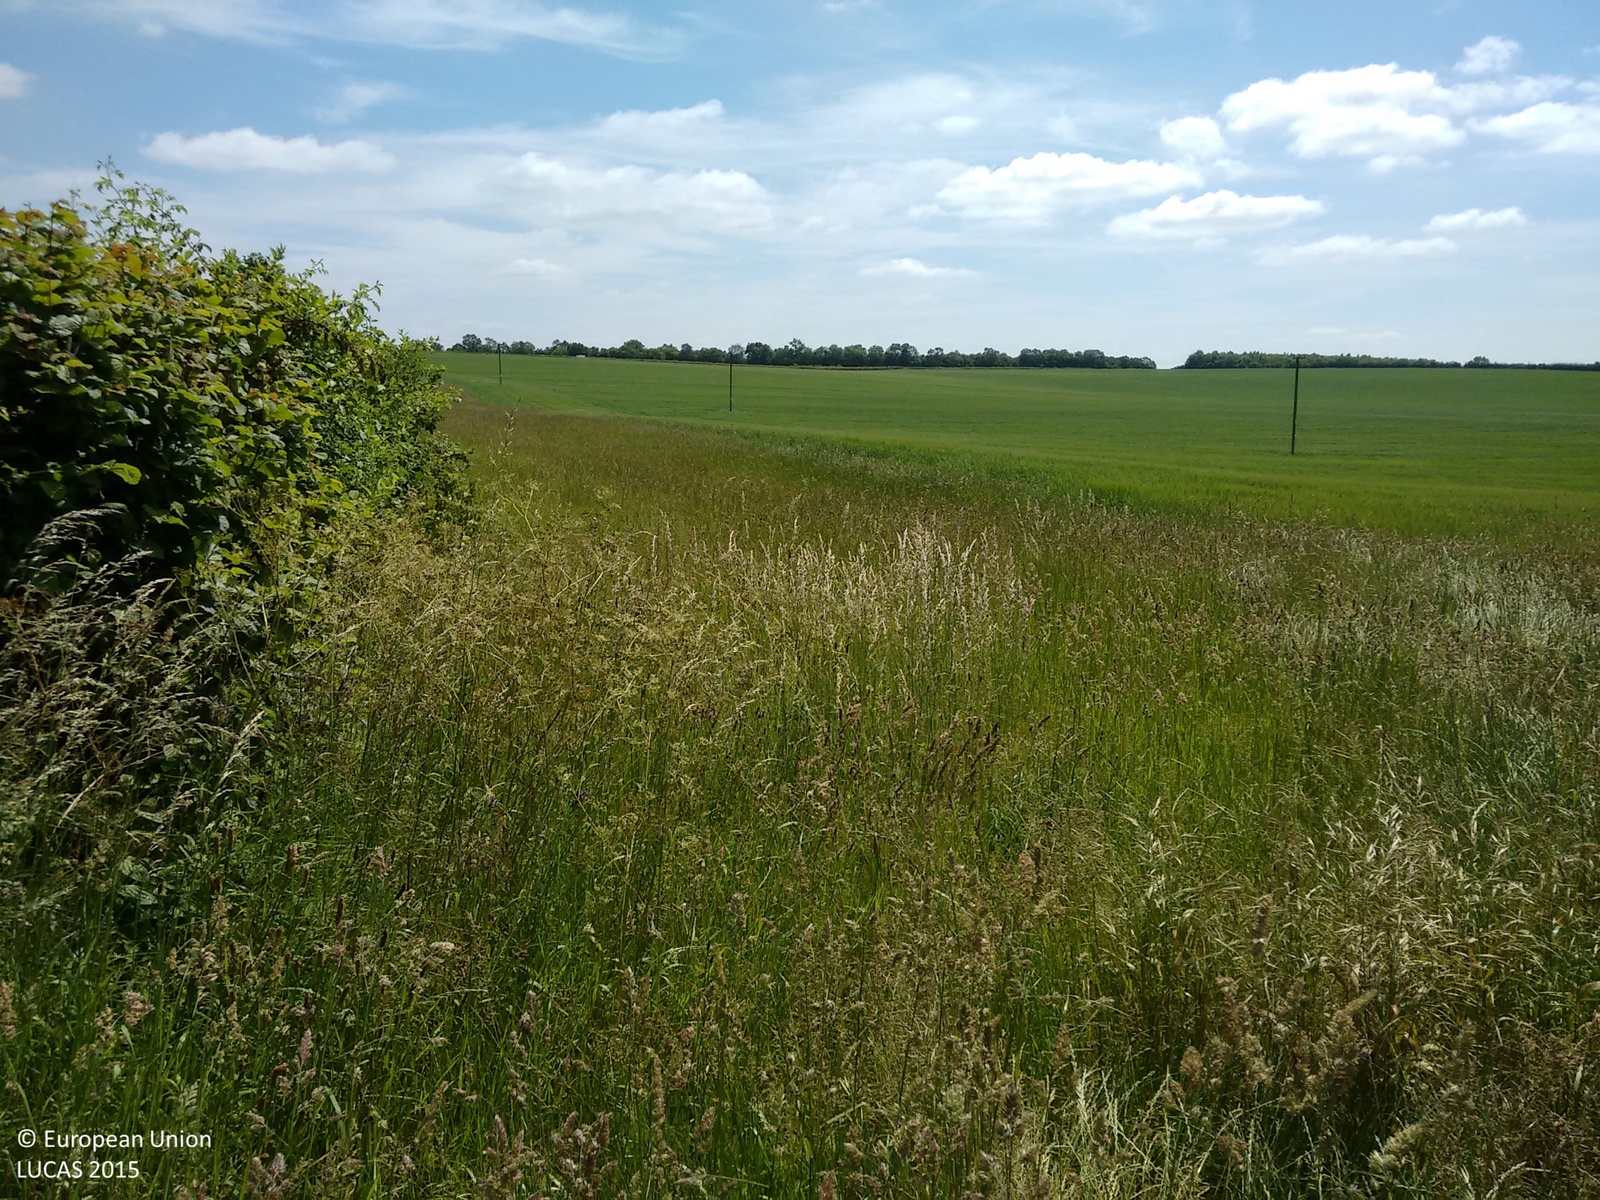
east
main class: Cropland
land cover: Barley
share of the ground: > 75 %
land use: Agriculture (excluding fallow land and kitchen gardens)
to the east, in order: Barley
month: June
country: GB
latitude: 51.8923
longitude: -1.2805
